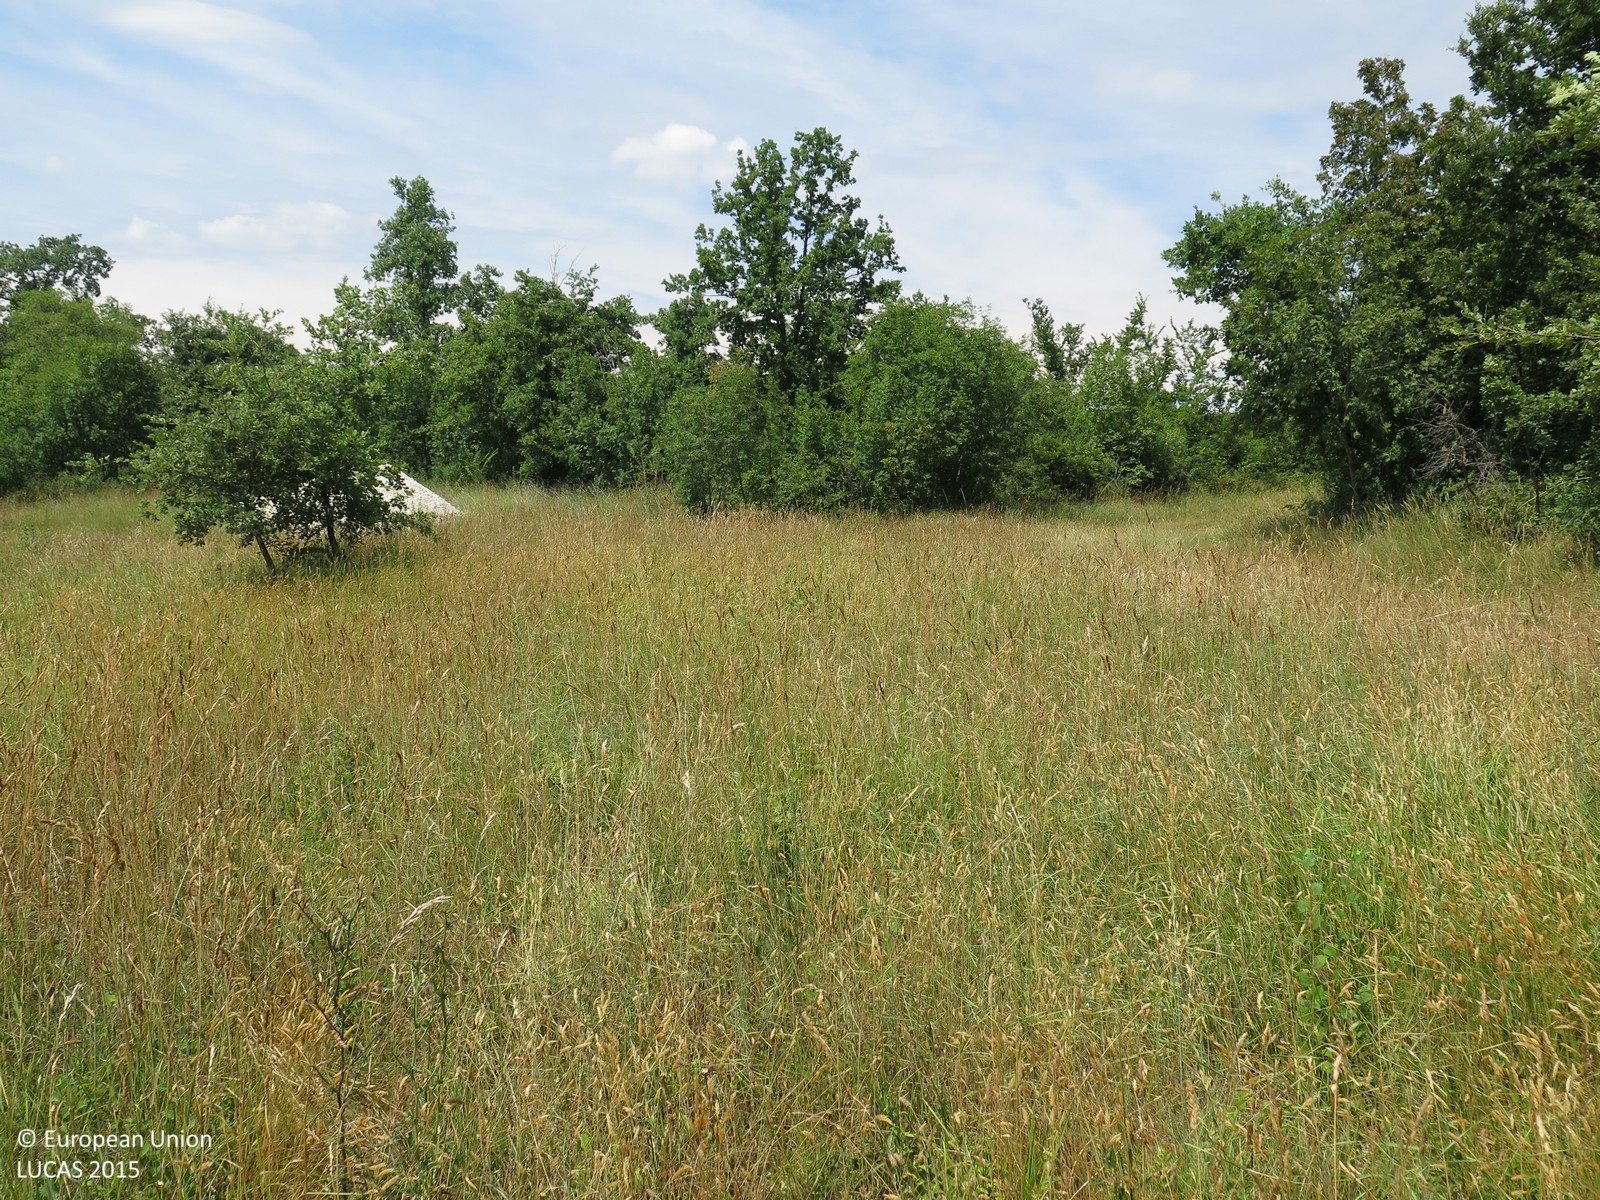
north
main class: Grassland
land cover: Grassland without tree/shrub cover
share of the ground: > 75 %
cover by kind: herbaceous plants 100 %
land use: Abandoned areas
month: June
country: HR
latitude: 45.1691
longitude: 13.6972
